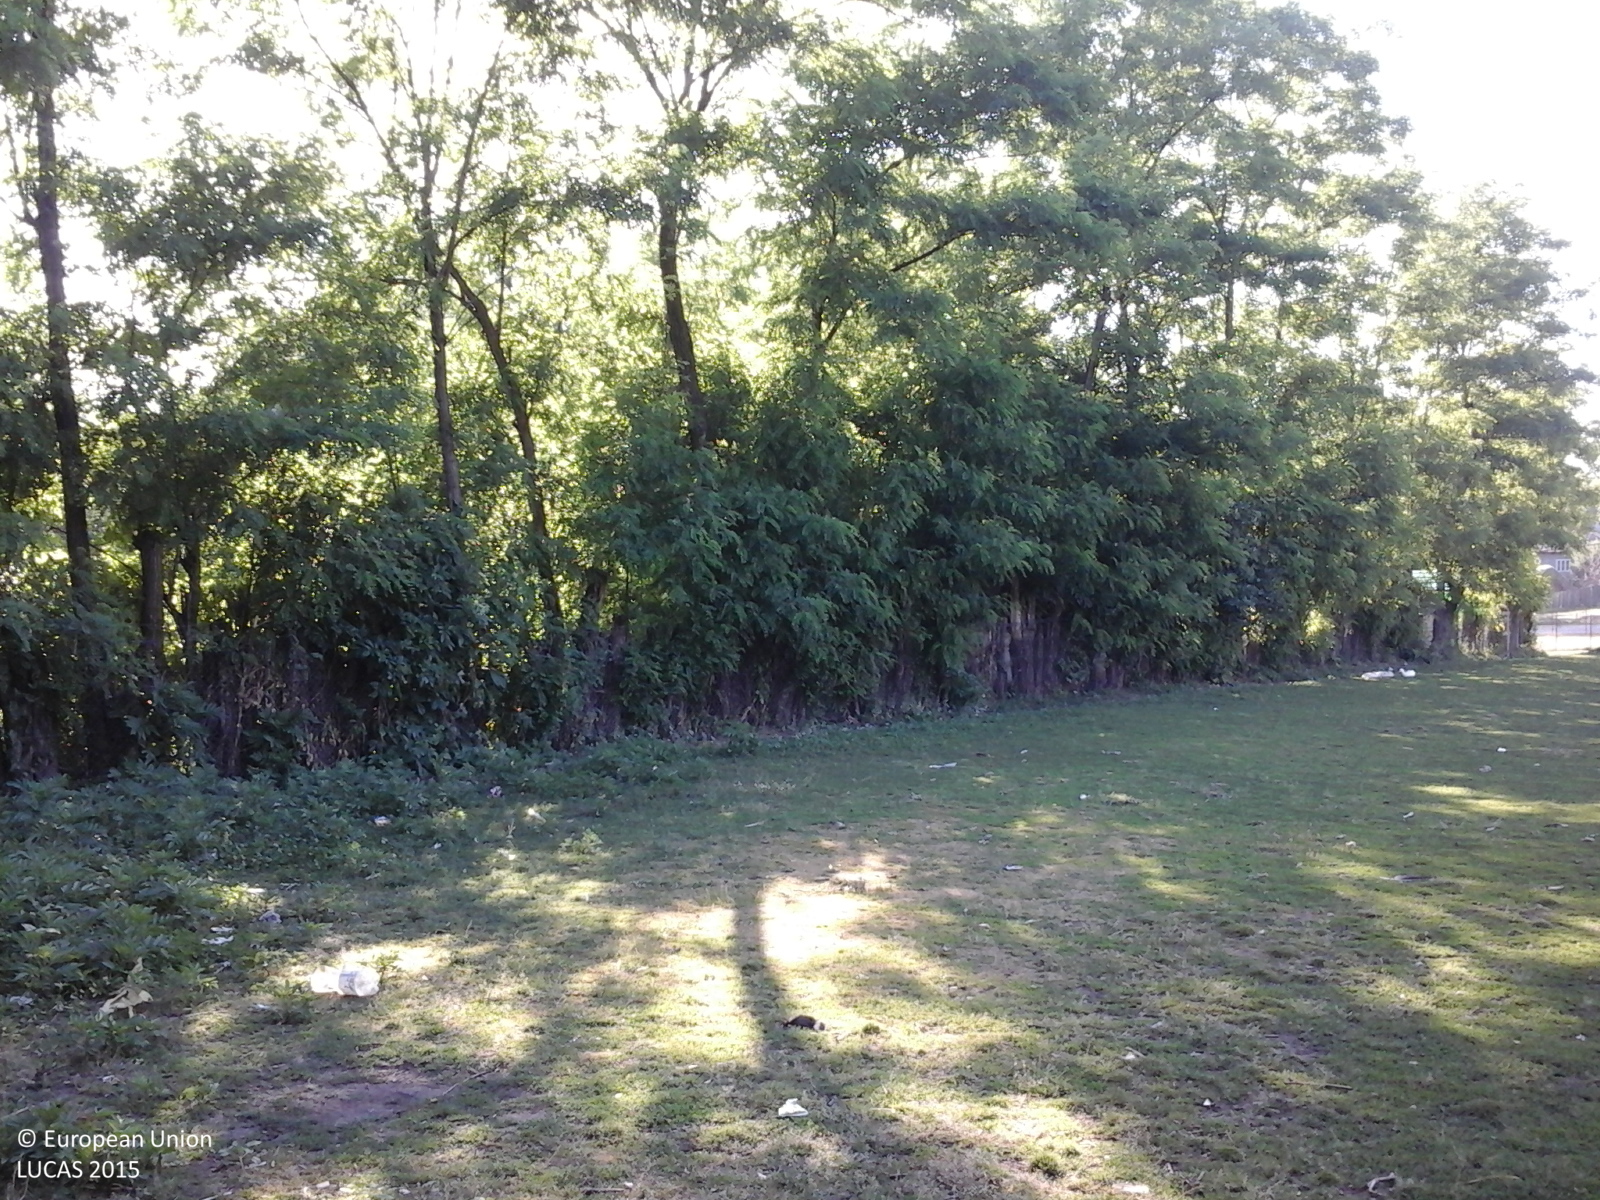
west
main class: Grassland
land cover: Grassland without tree/shrub cover
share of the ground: > 75 %
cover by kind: herbaceous plants 100 %
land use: Sport
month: June
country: RO
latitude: 47.4627
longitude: 27.0994
